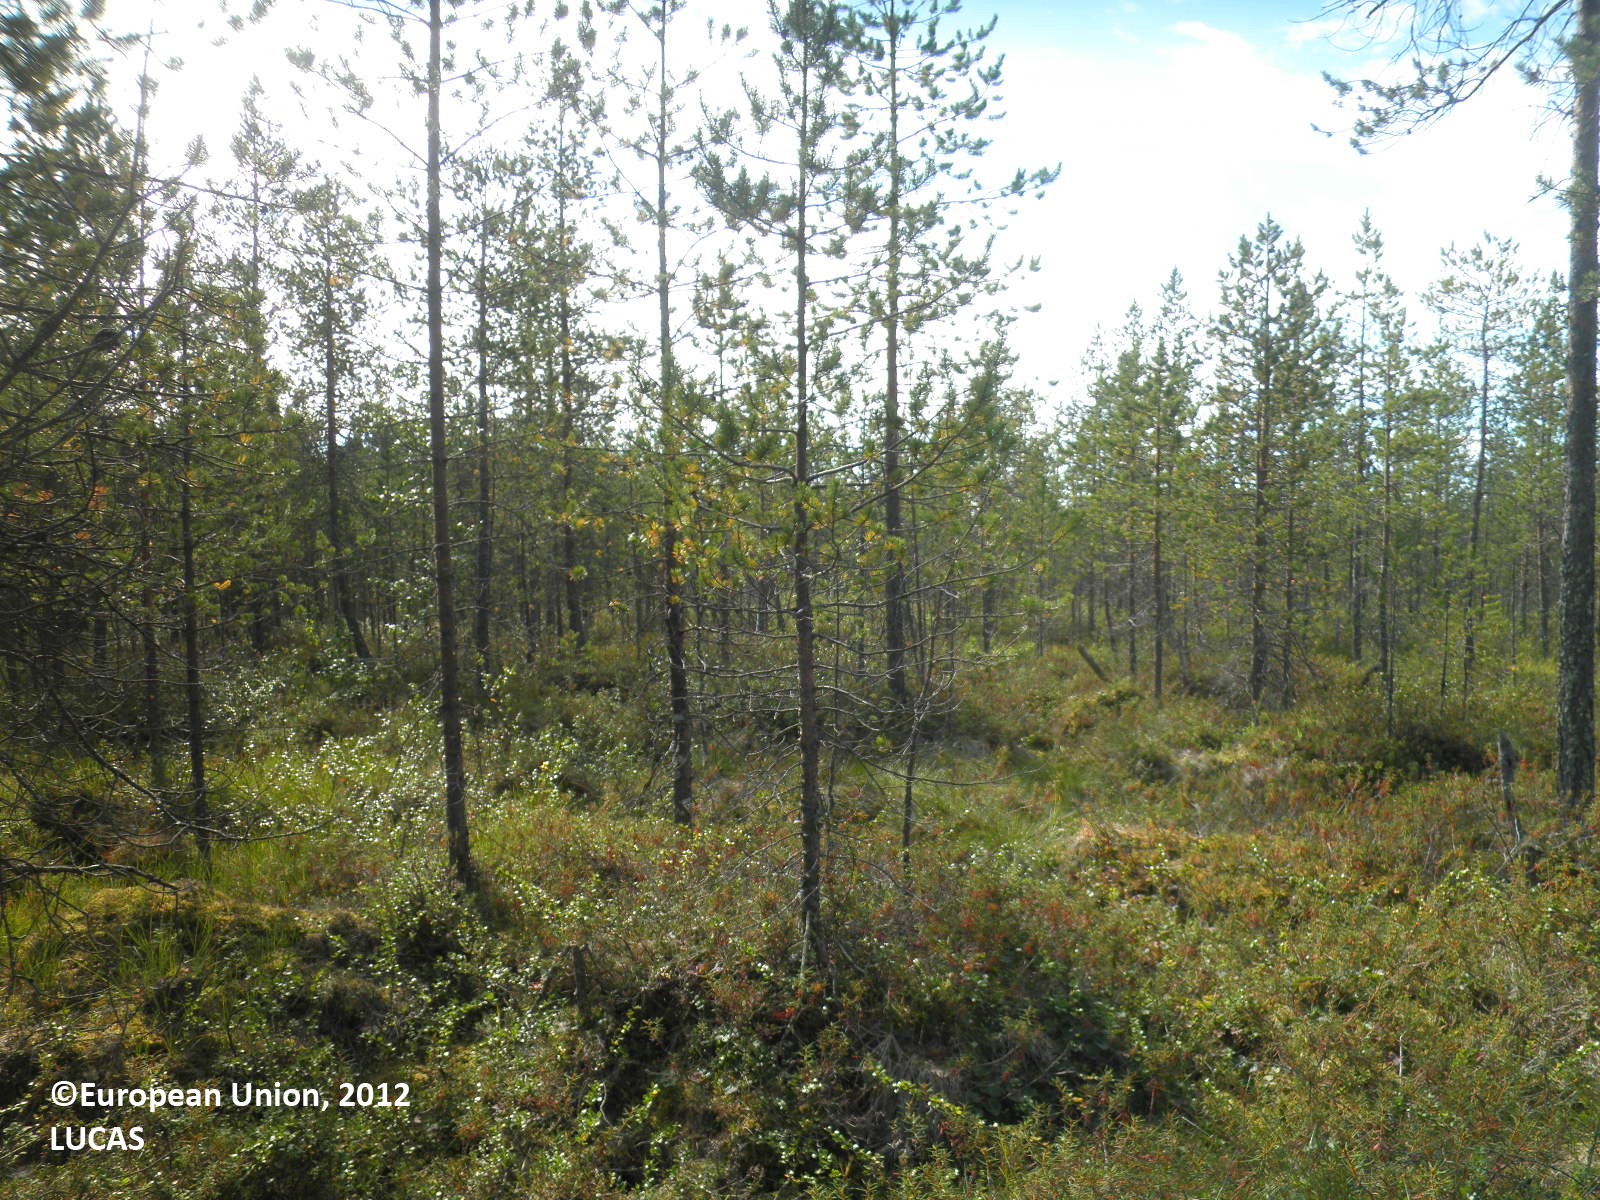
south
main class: Woodland
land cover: Pine dominated coniferous woodland
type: boreal forest
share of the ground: 25 - 50 %
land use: Forestry
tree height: > 5 m
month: August
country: FI
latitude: 67.4777
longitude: 26.9505
